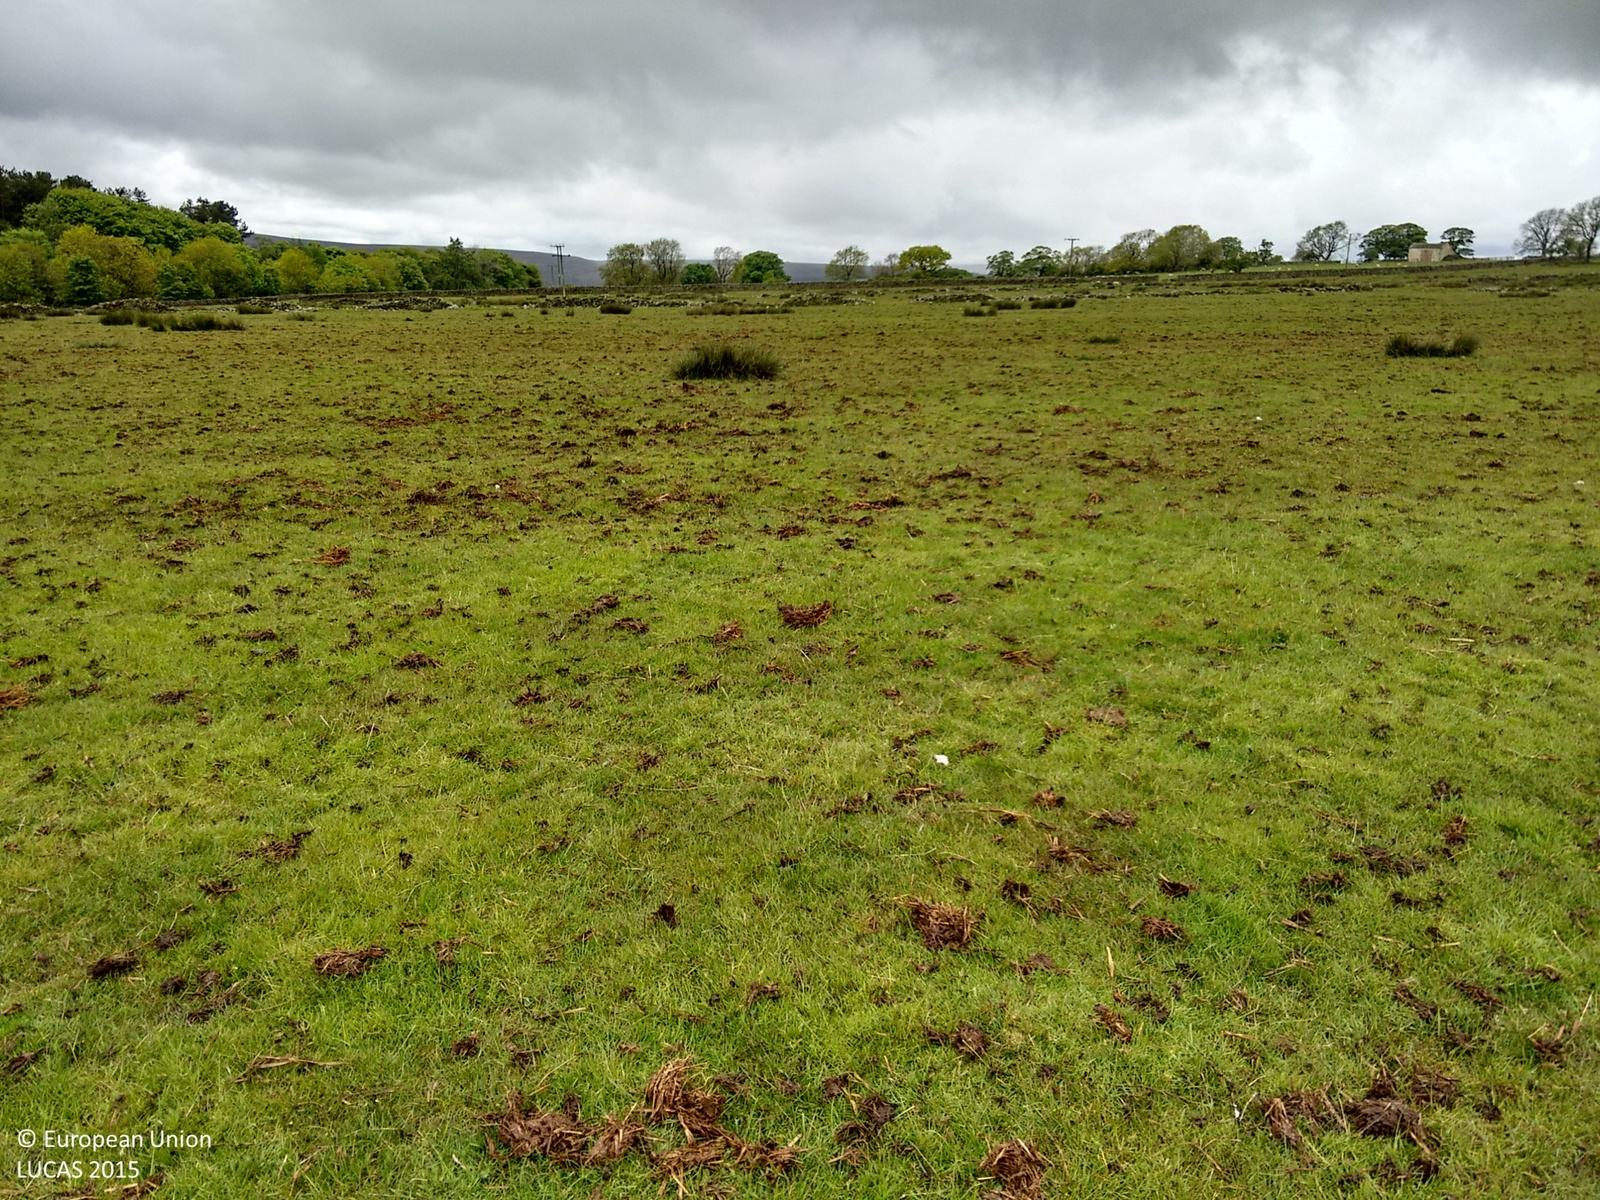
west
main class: Grassland
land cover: Grassland without tree/shrub cover
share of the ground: > 75 %
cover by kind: herbaceous plants 100 %
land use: Agriculture (excluding fallow land and kitchen gardens)
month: May
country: GB
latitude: 53.9937
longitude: -1.7214
